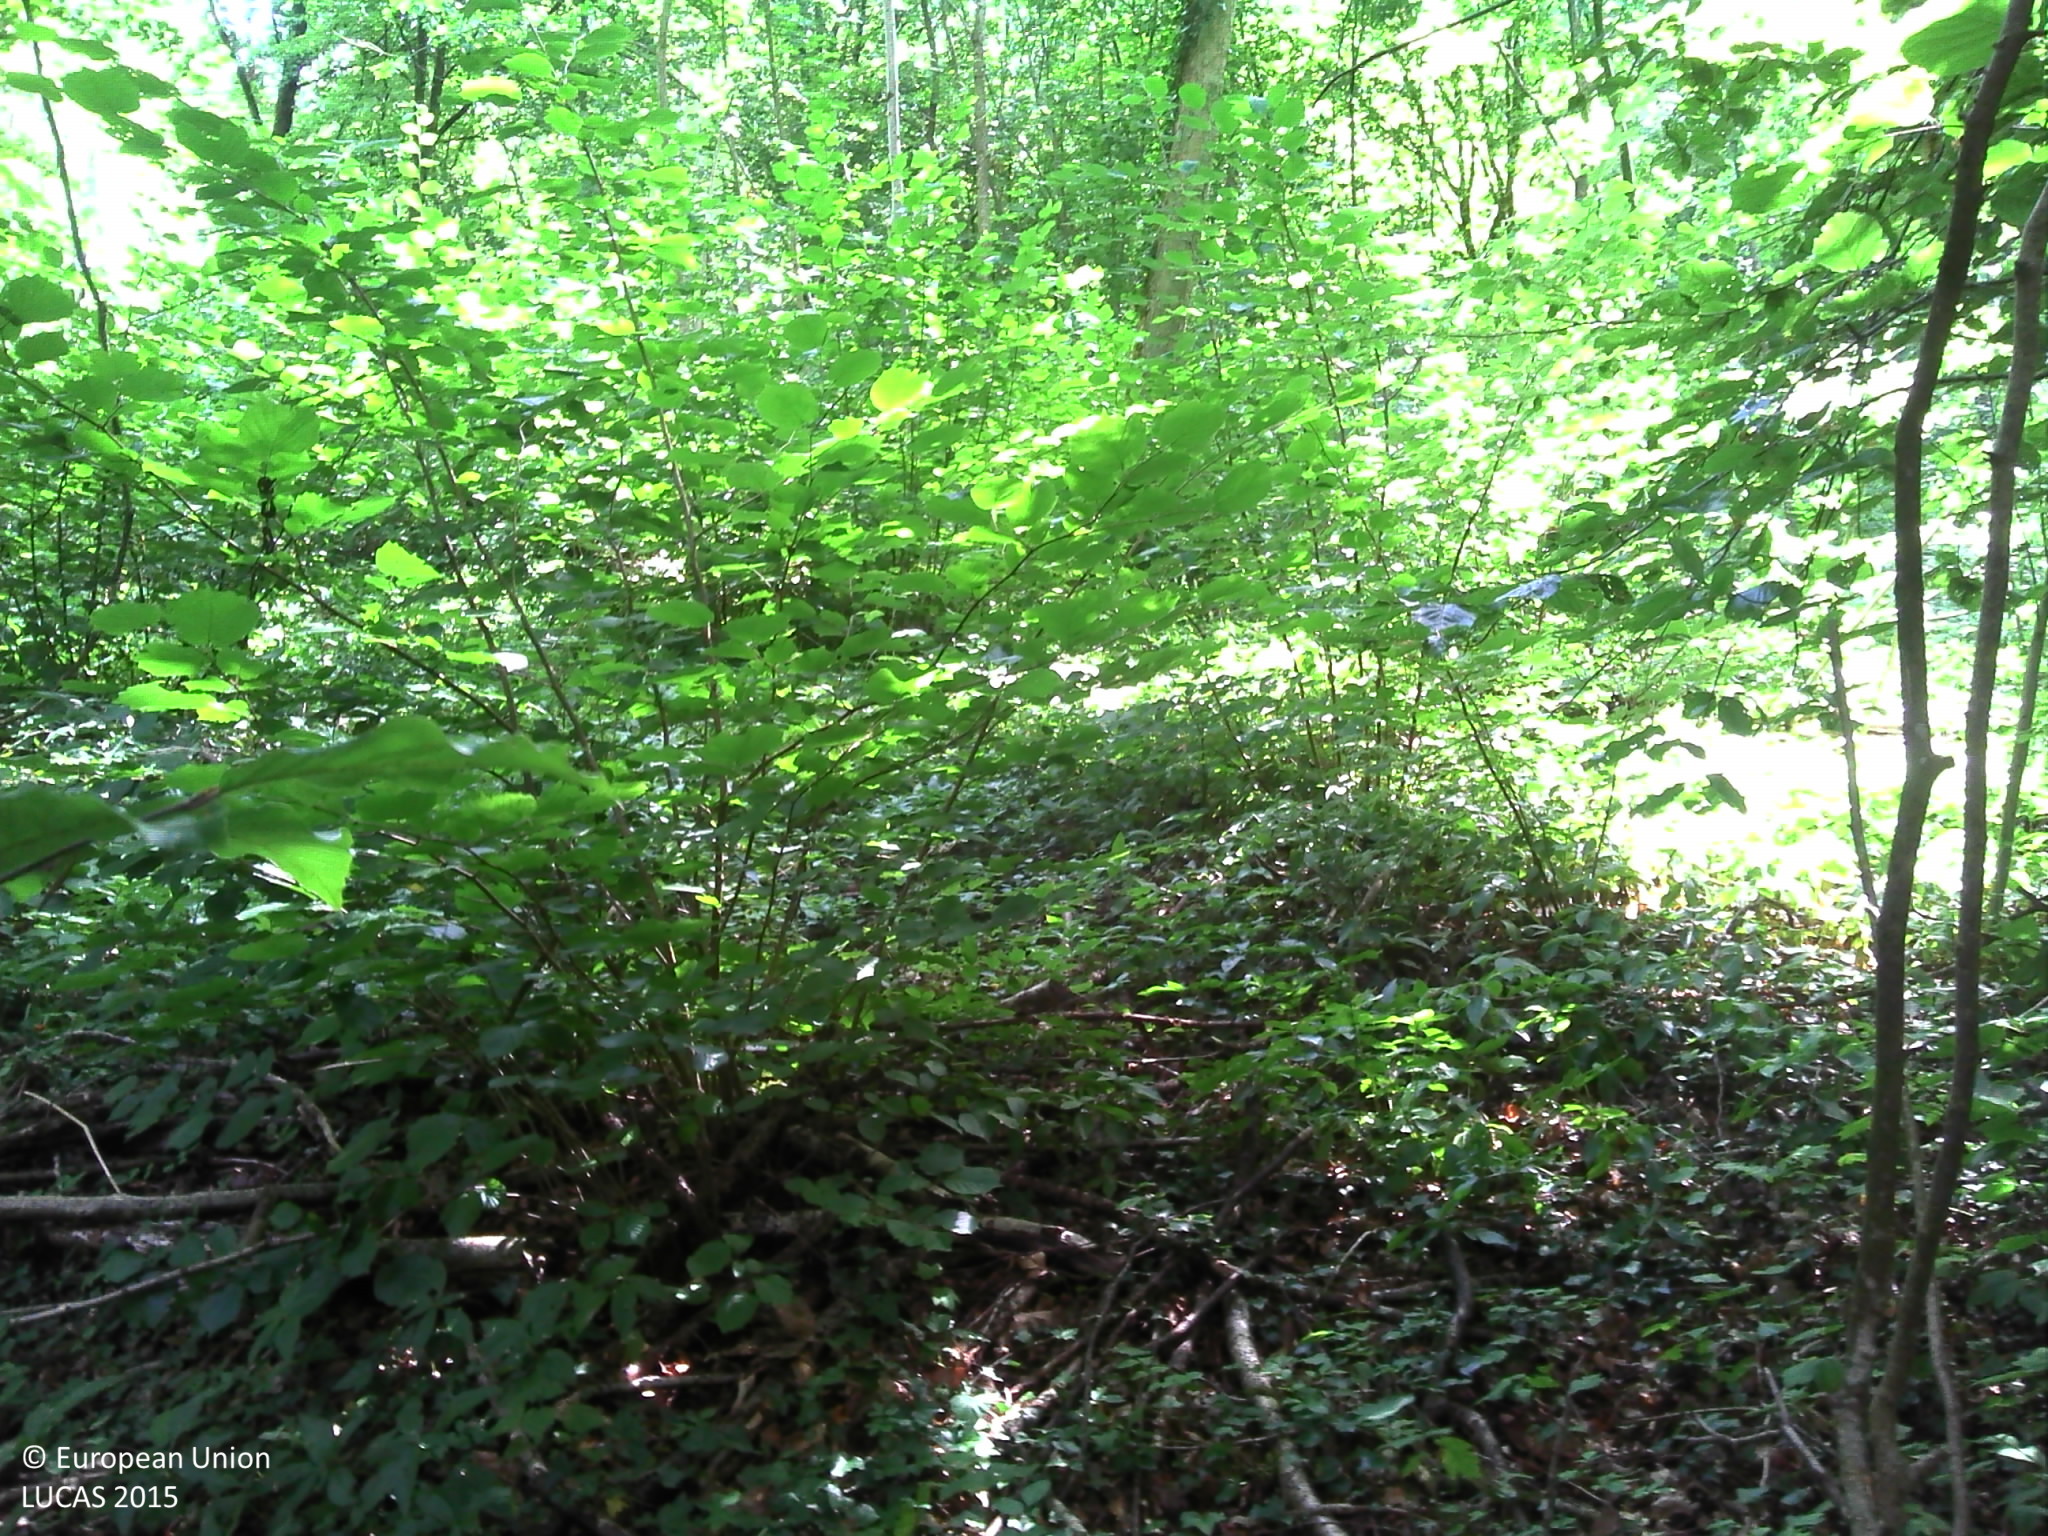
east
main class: Woodland
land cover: Broadleaved woodland
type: mesophytic deciduous forest
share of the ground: > 75 %
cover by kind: broadleaved forest trees 95 %, shrubs 5 %
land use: Forestry
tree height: > 5 m
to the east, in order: Broadleaved woodland; Tracks; Broadleaved woodland; Tracks; Broadleaved woodland
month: July
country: BE
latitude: 49.5238
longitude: 5.6195
